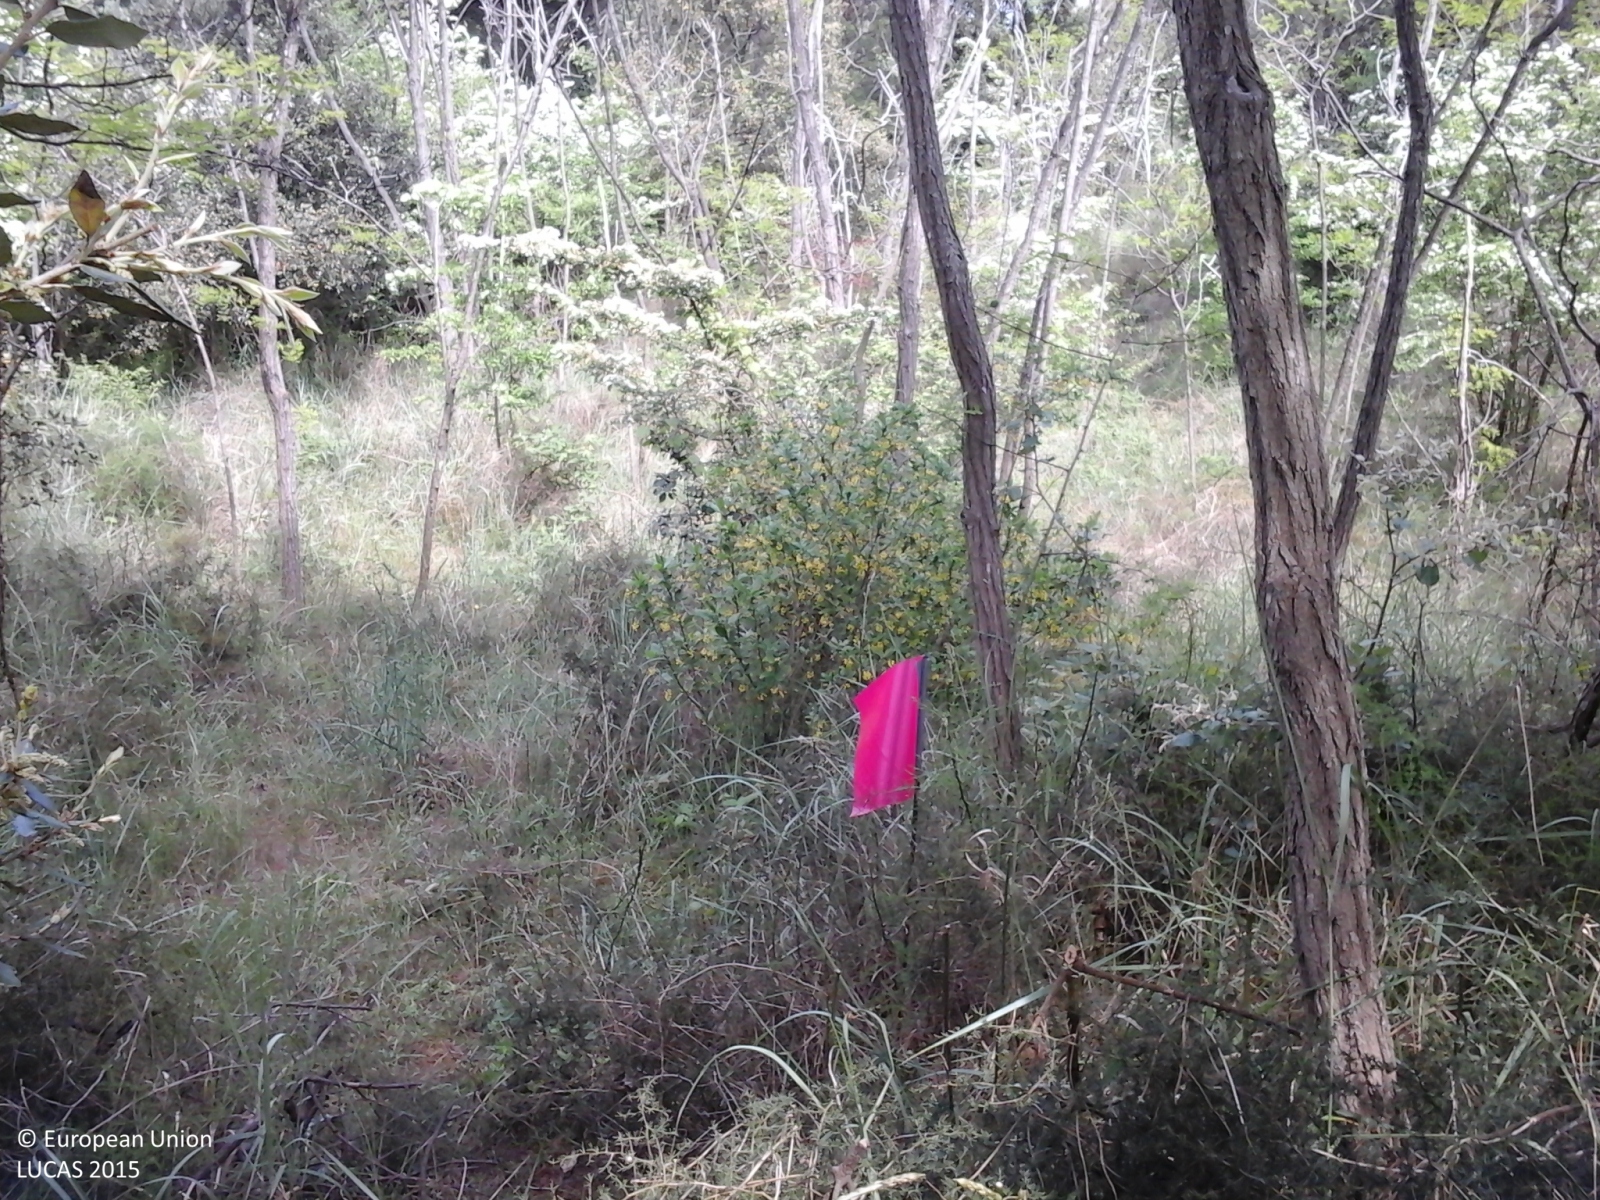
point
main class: Woodland
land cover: Pine dominated mixed woodland
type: coniferous forest of the mediterranean region
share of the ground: > 75 %
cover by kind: coniferous forest trees 40 %, broadleaved forest trees 20 %, shrubs 20 %, herbaceous plants 20 %
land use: Amenities, museums, leisure
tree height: > 5 m
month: May
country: IT
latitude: 45.5241
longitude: 12.6975
